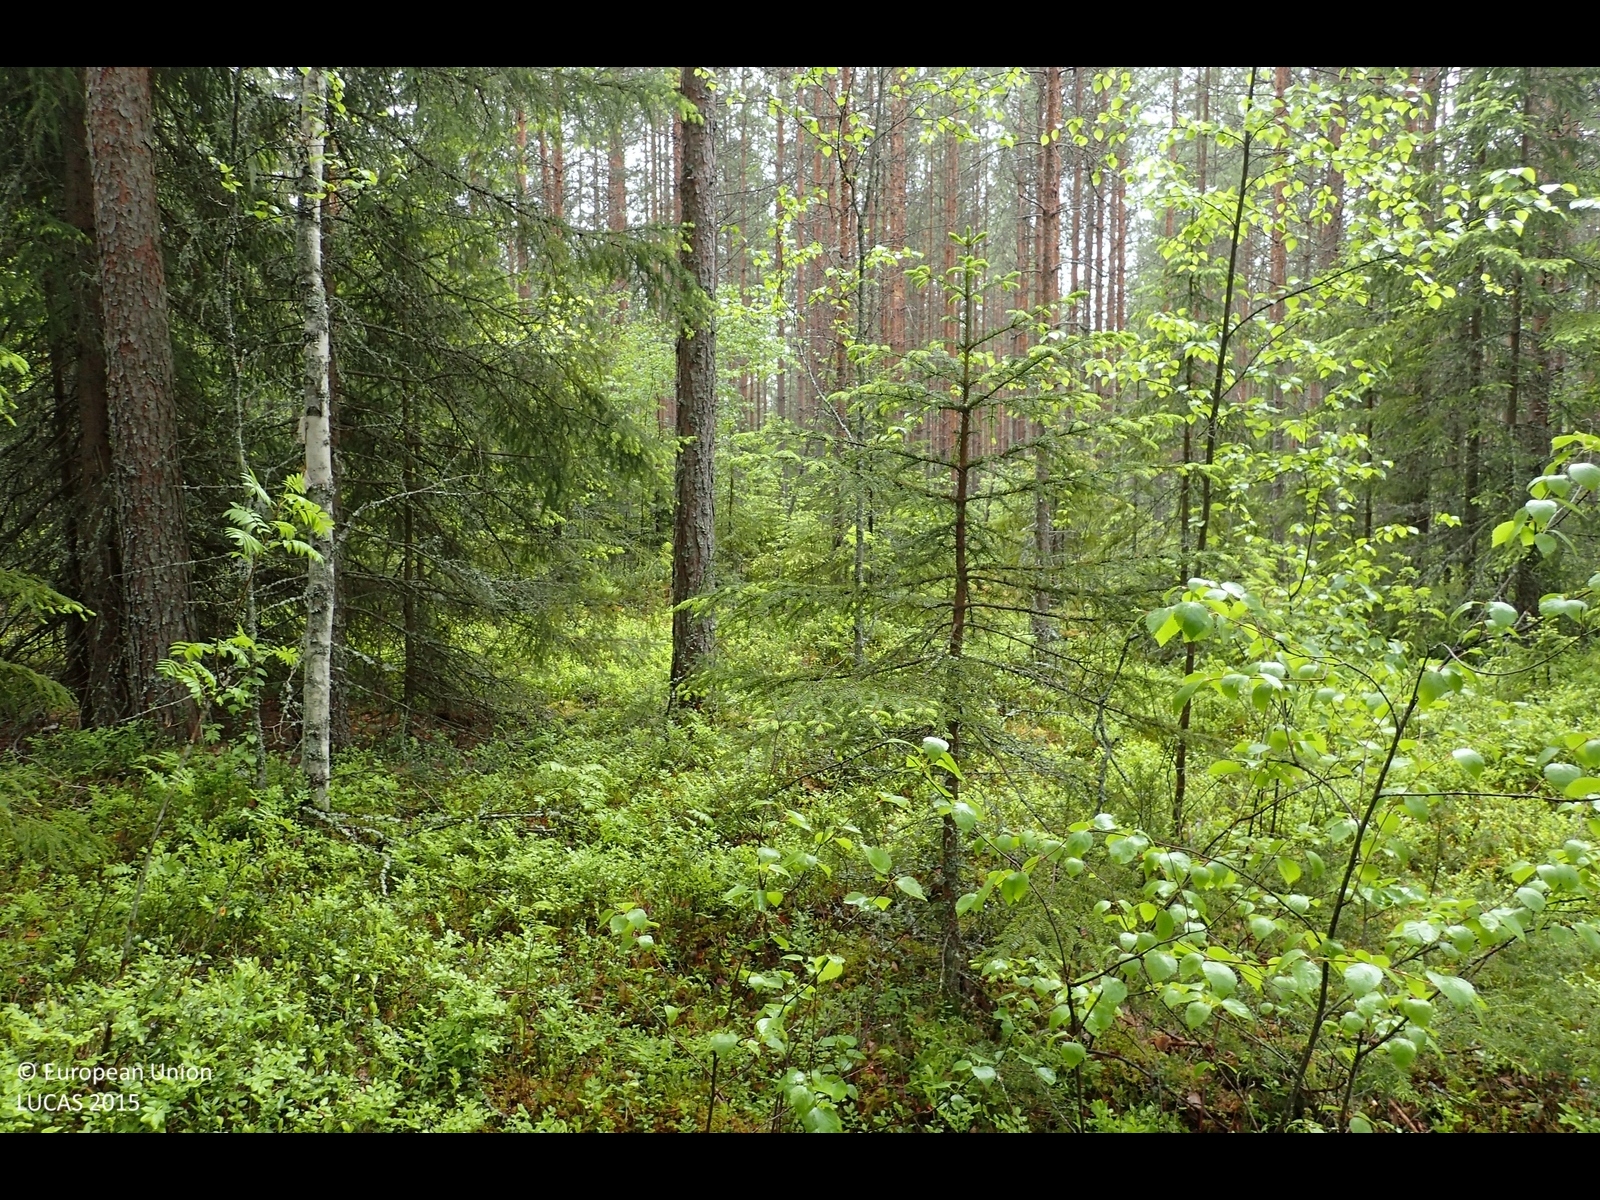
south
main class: Woodland
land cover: Pine dominated coniferous woodland
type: boreal forest
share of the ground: > 75 %
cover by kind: coniferous forest trees 75 %, shrubs 20 %, broadleaved forest trees 5 %
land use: Forestry
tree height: > 5 m
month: June
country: FI
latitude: 62.3515
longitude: 23.0654
